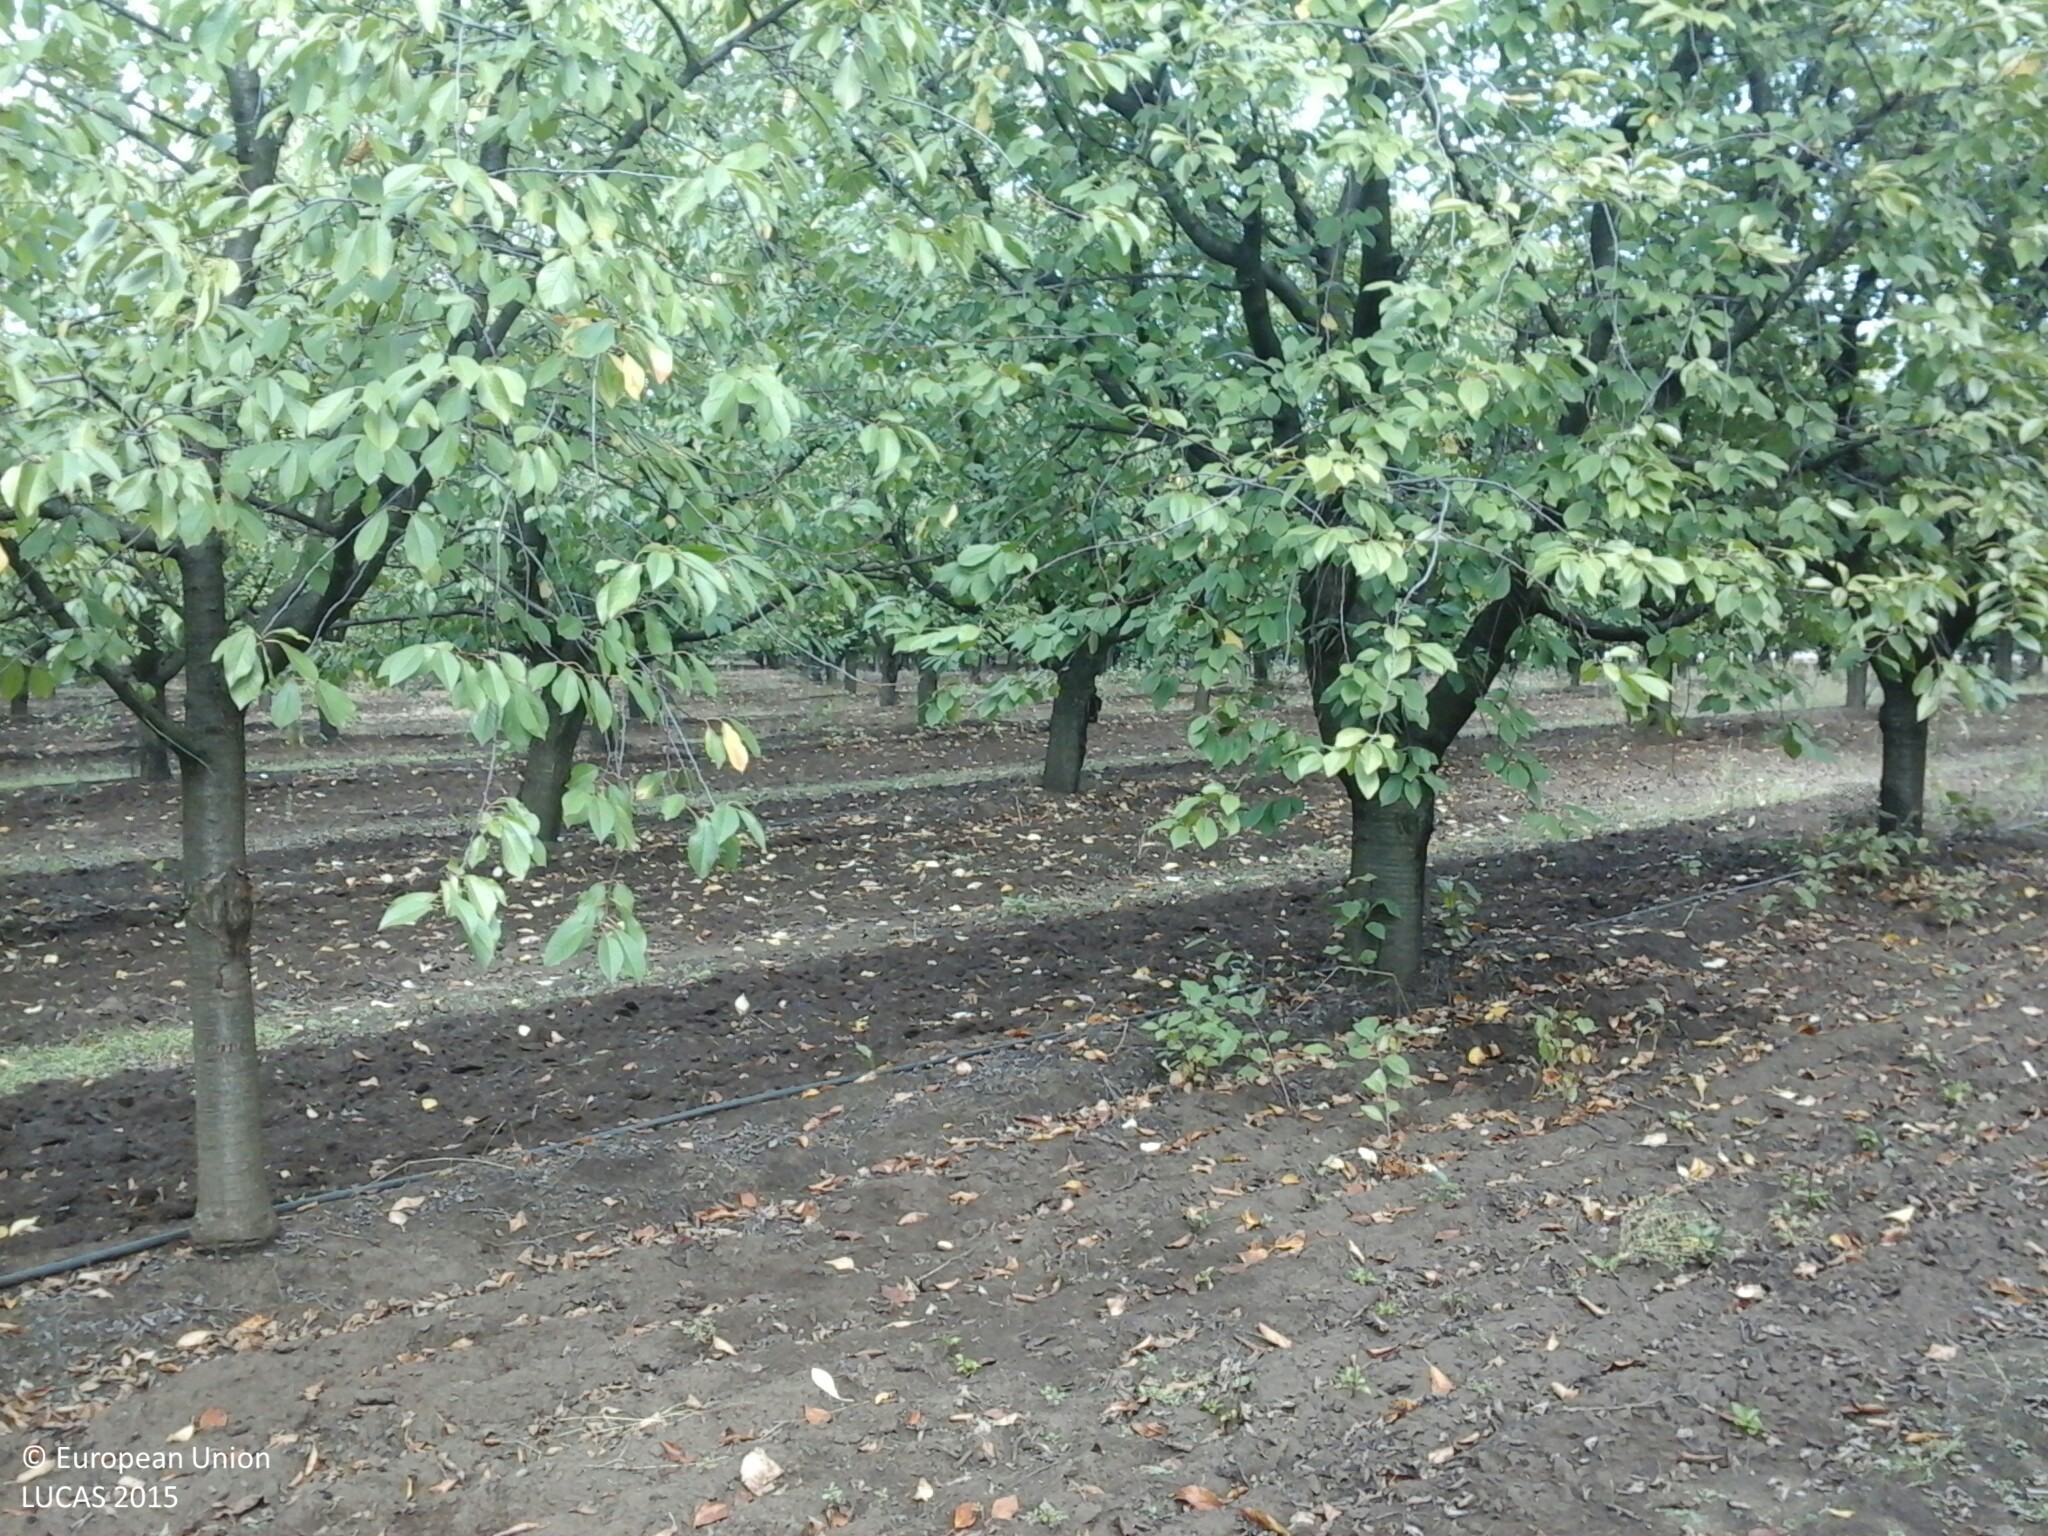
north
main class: Cropland
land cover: Cherry fruit
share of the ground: 50 - 75 %
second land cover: Other bare soil
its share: > 75 %
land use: Agriculture (excluding fallow land and kitchen gardens)
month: September
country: HU
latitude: 47.6650
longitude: 20.3238
